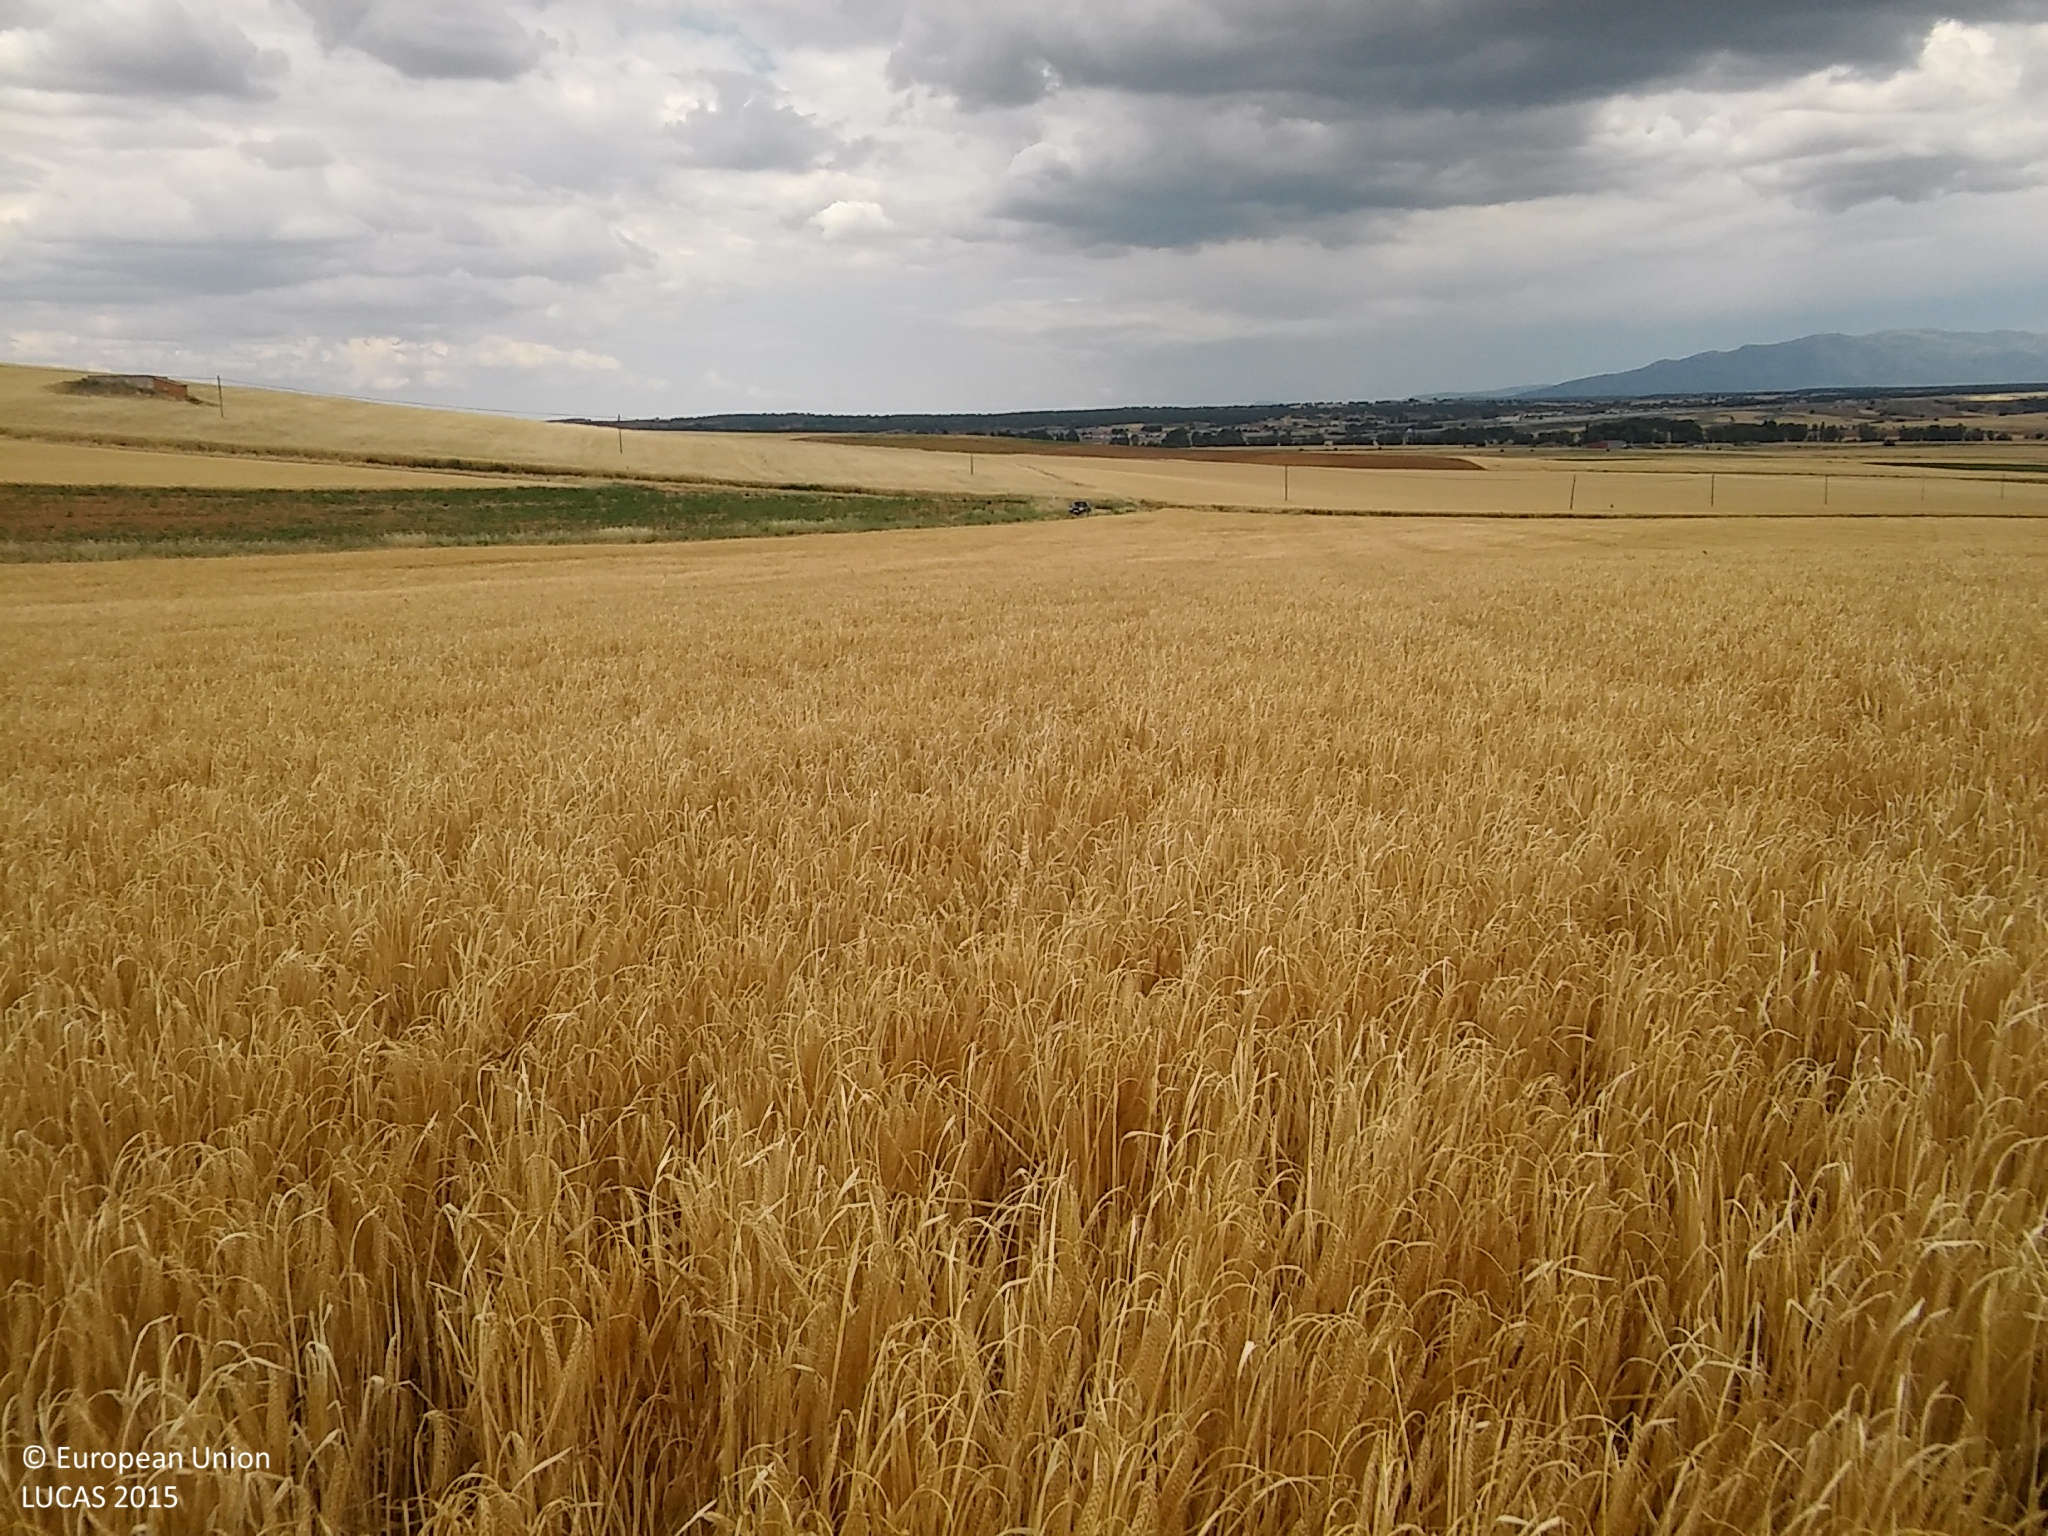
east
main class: Cropland
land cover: Barley
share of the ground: > 75 %
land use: Agriculture (excluding fallow land and kitchen gardens)
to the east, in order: Barley; Grass margins; Ditches and canals; Grass margins; Tracks; Paved roads, cycling and walking lanes; Grass margins; Common wheat
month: June
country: ES
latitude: 41.3363
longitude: -3.6830
